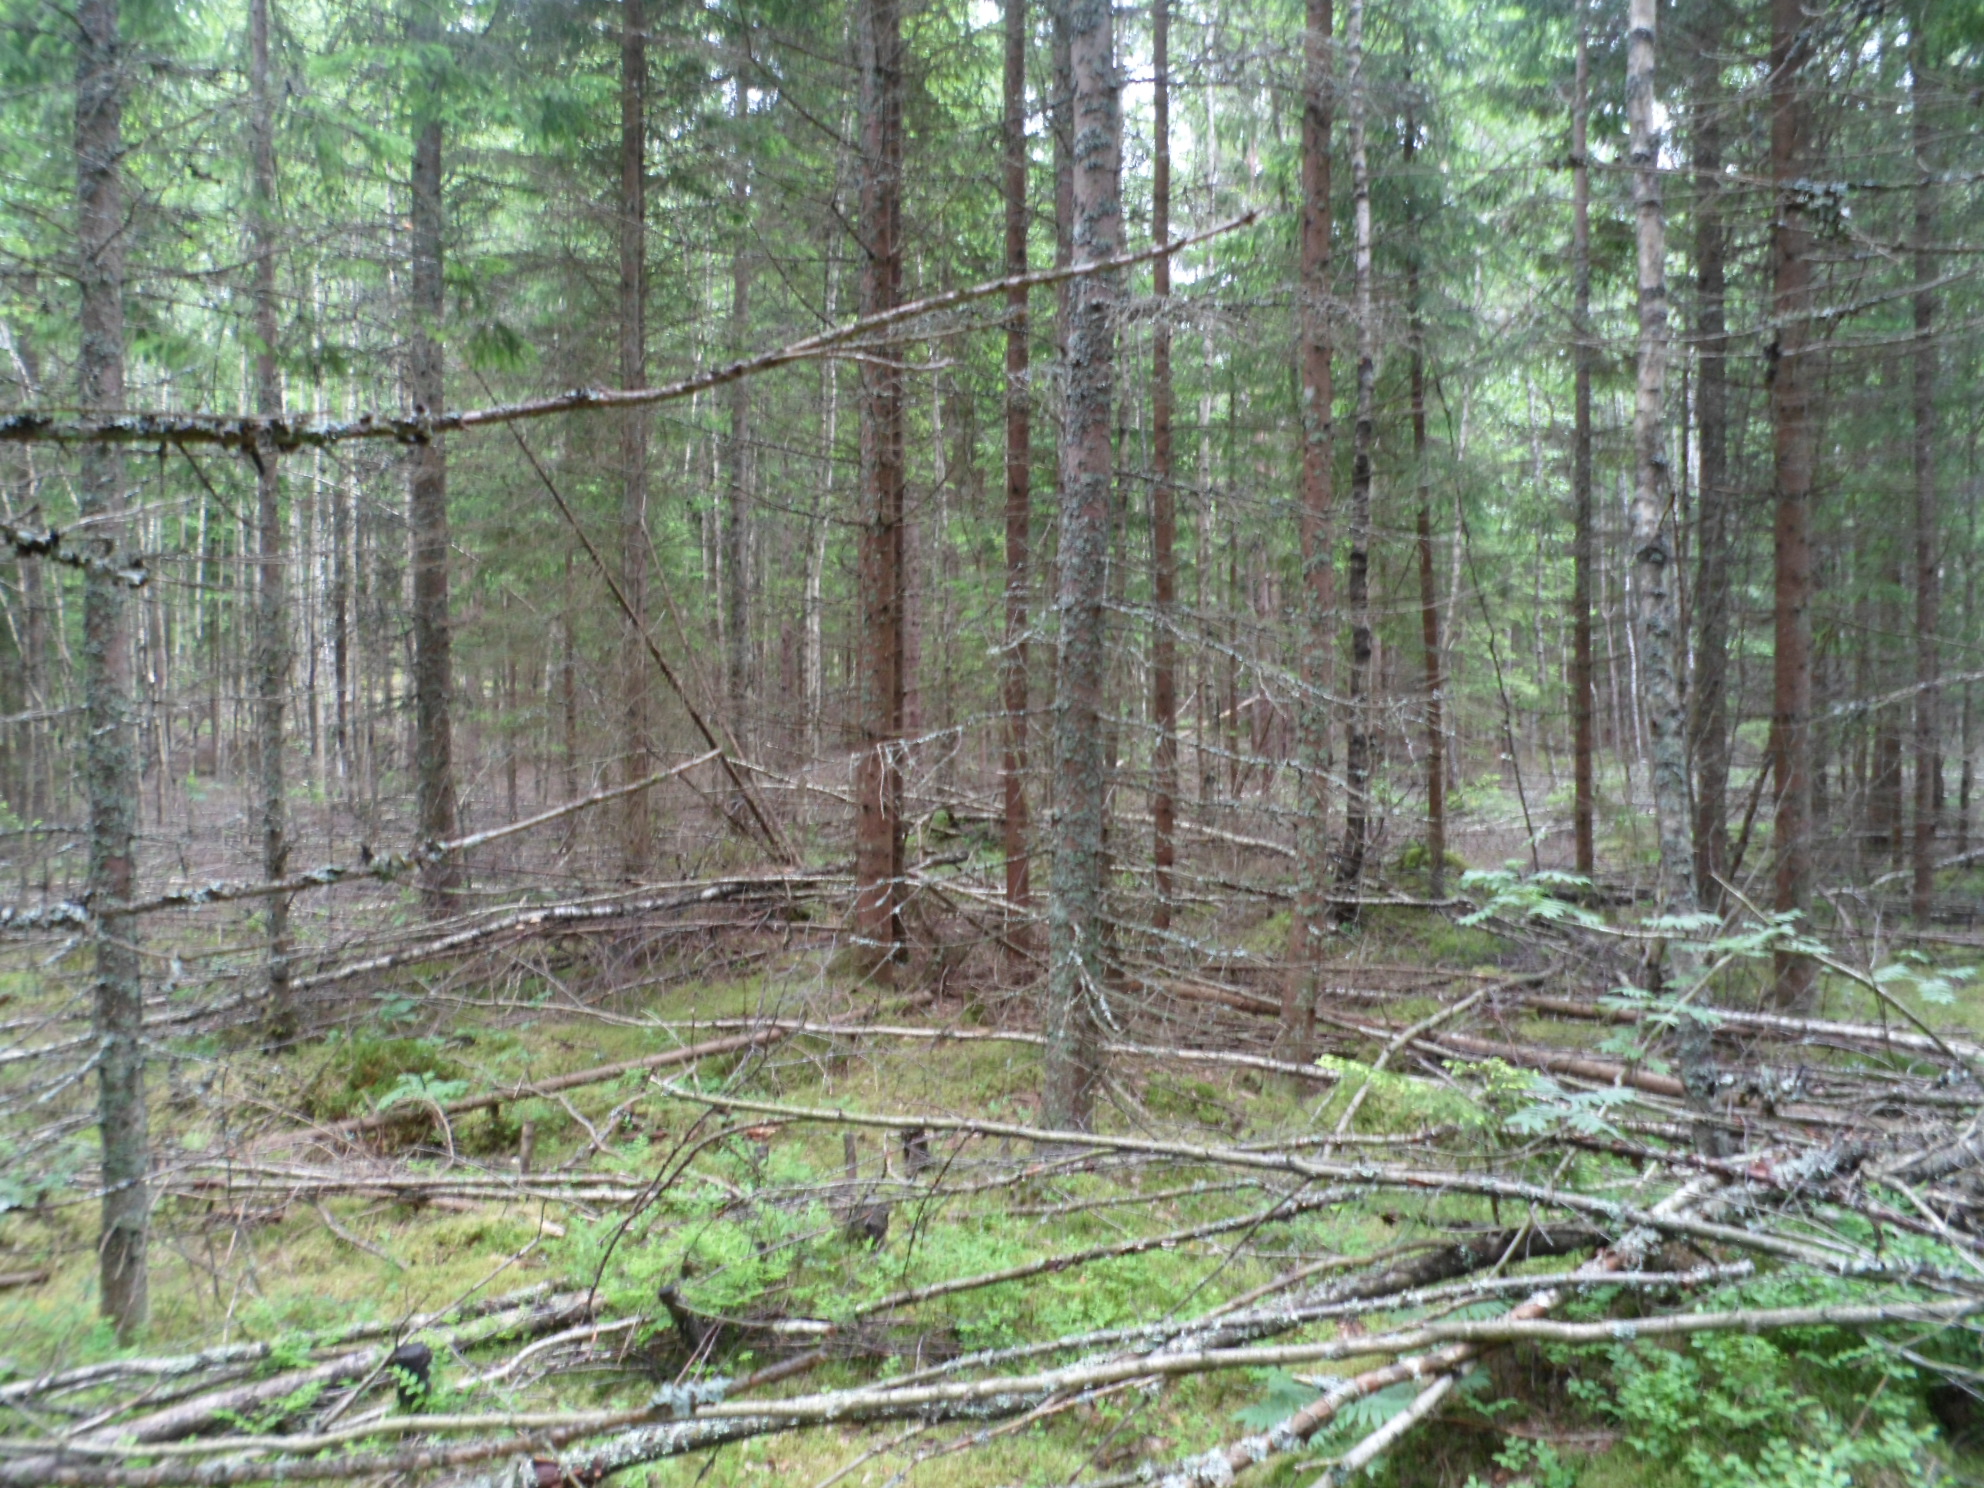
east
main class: Woodland
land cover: Spruce dominated coniferous woodland
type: boreal forest
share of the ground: > 75 %
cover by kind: coniferous forest trees 75 %, lichens and mosses 15 %, shrubs 5 %, herbaceous plants 5 %
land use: Forestry
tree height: > 5 m
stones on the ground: 10 - 25 %
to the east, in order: Spruce dominated coniferous woodland; Spruce dominated mixed woodland; Tracks; Spruce dominated coniferous woodland
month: June
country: SE
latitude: 57.0379
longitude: 15.1884
